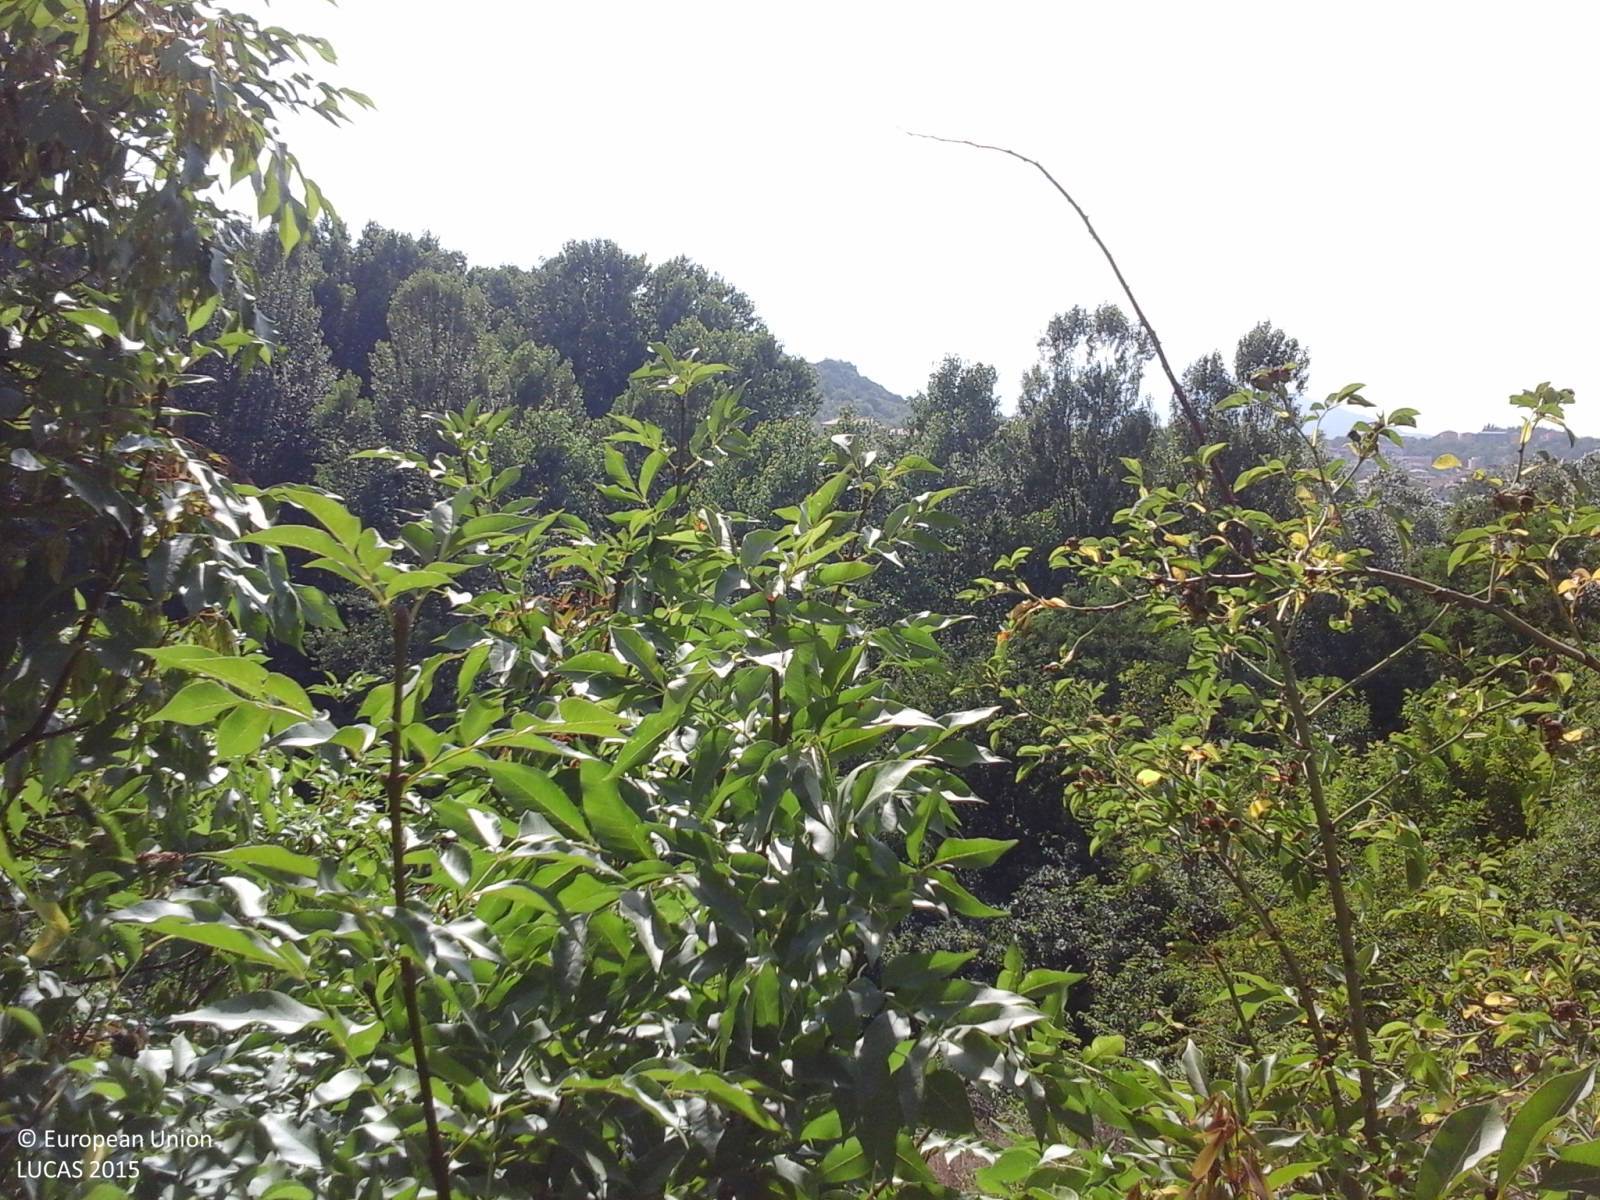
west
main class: Cropland
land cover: Nuts trees
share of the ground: 25 - 50 %
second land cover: Grassland without tree/shrub cover
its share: 50 - 75 %
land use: Agriculture (excluding fallow land and kitchen gardens)
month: July
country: IT
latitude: 42.3635
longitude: 13.3526
